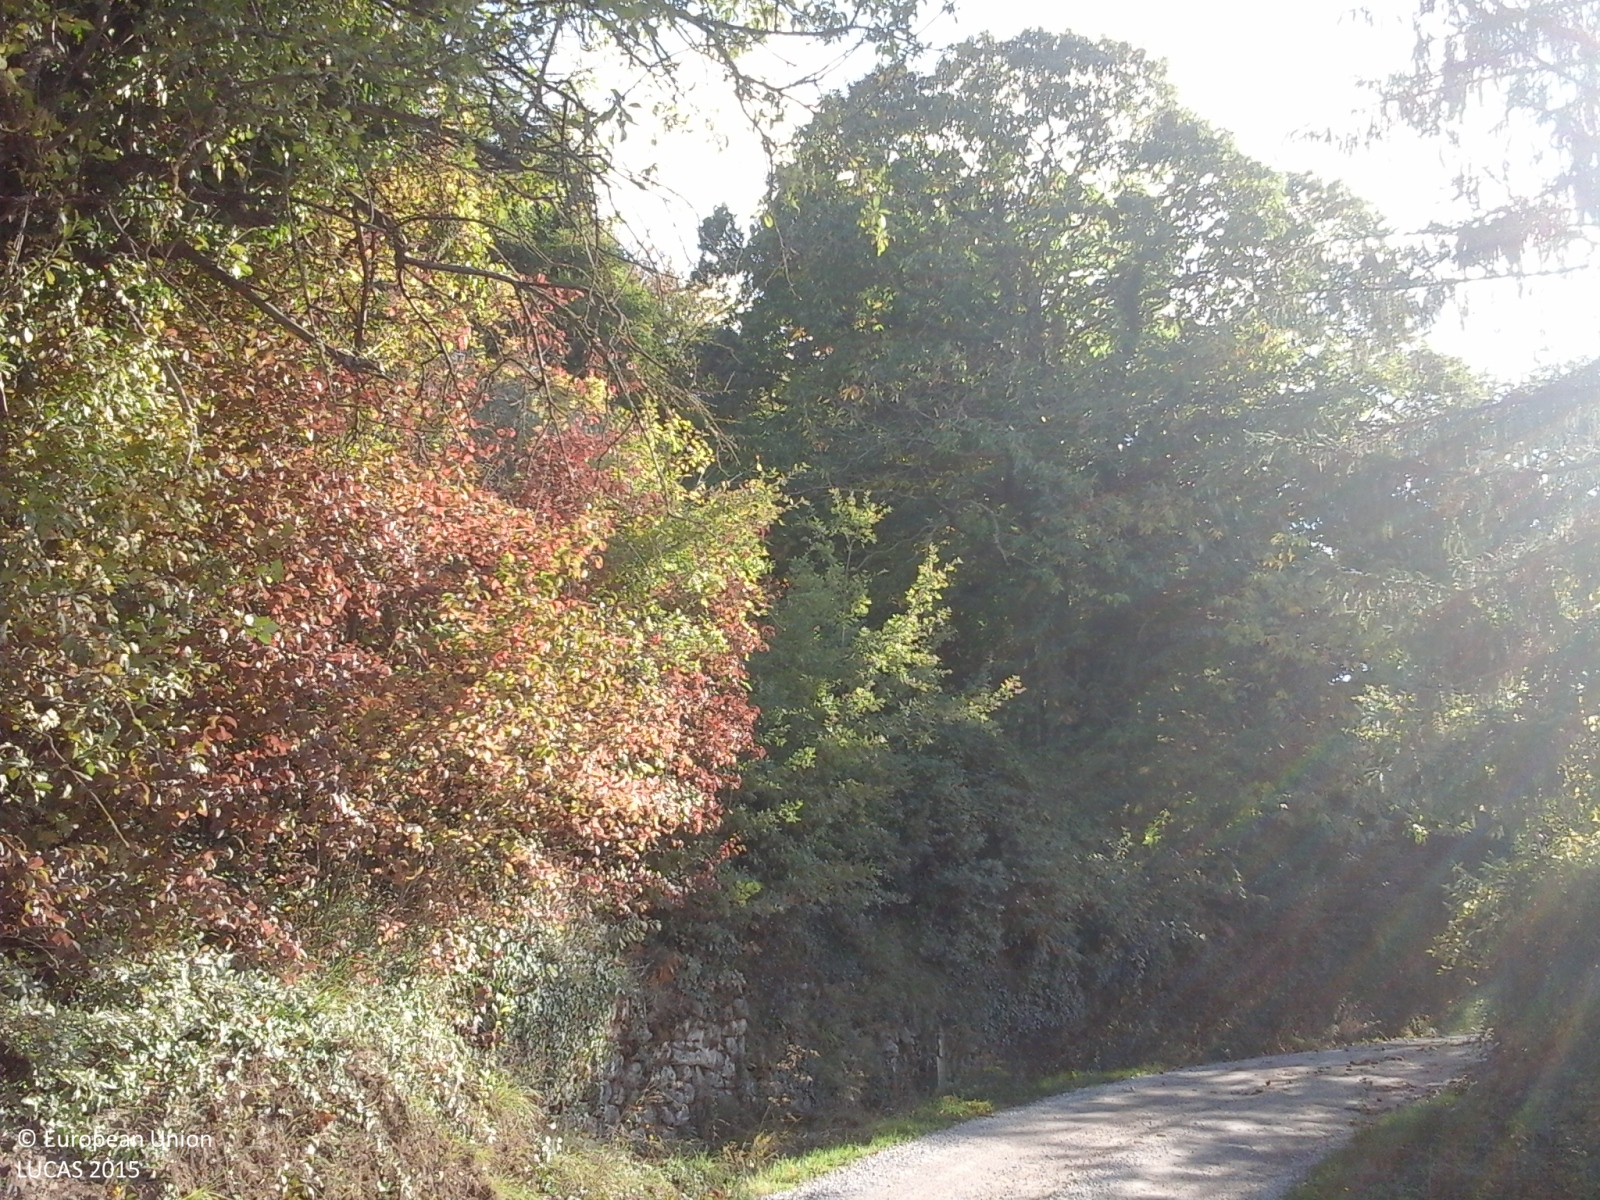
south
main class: Cropland
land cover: Olive groves
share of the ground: 50 - 75 %
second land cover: Spontaneously vegetated surfaces
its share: > 75 %
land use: Agriculture (excluding fallow land and kitchen gardens)
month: October
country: IT
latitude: 43.2438
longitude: 12.2228
